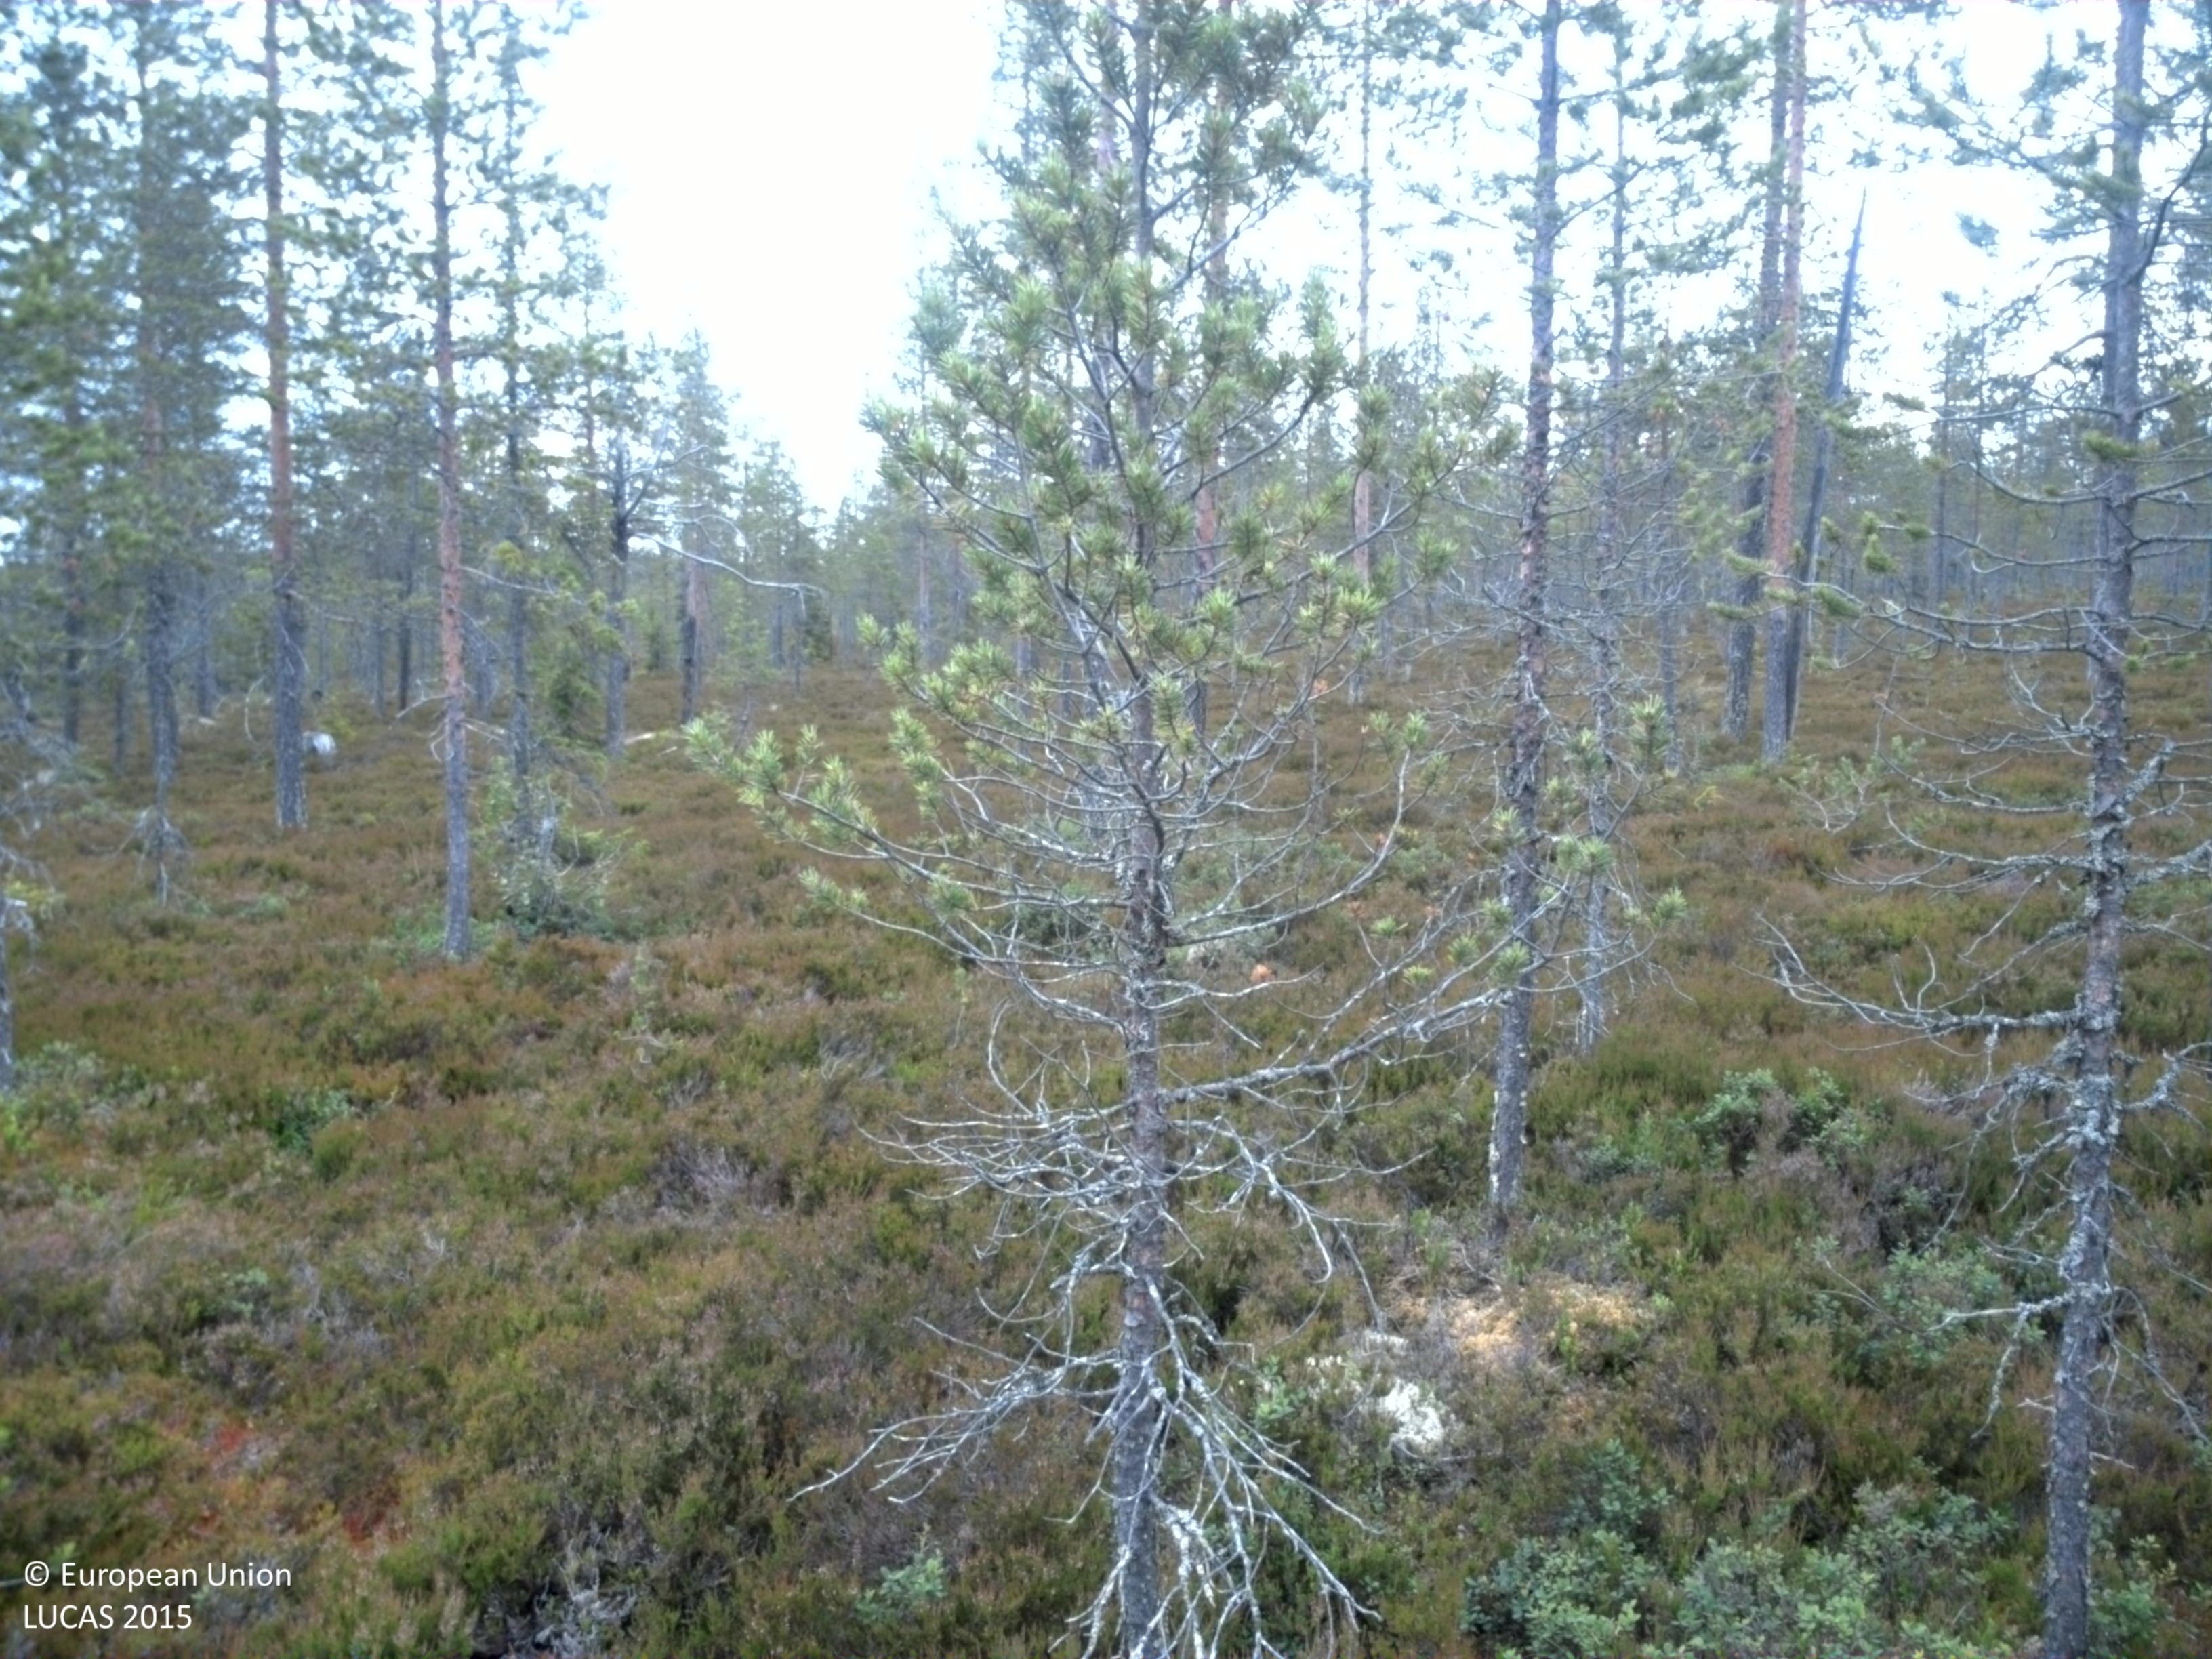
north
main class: Woodland
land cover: Pine dominated coniferous woodland
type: exotic forest
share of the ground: 25 - 50 %
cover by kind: coniferous forest trees 50 %, shrubs 45 %, lichens and mosses 5 %
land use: Forestry
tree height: > 5 m
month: August
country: SE
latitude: 61.6122
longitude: 14.3028
